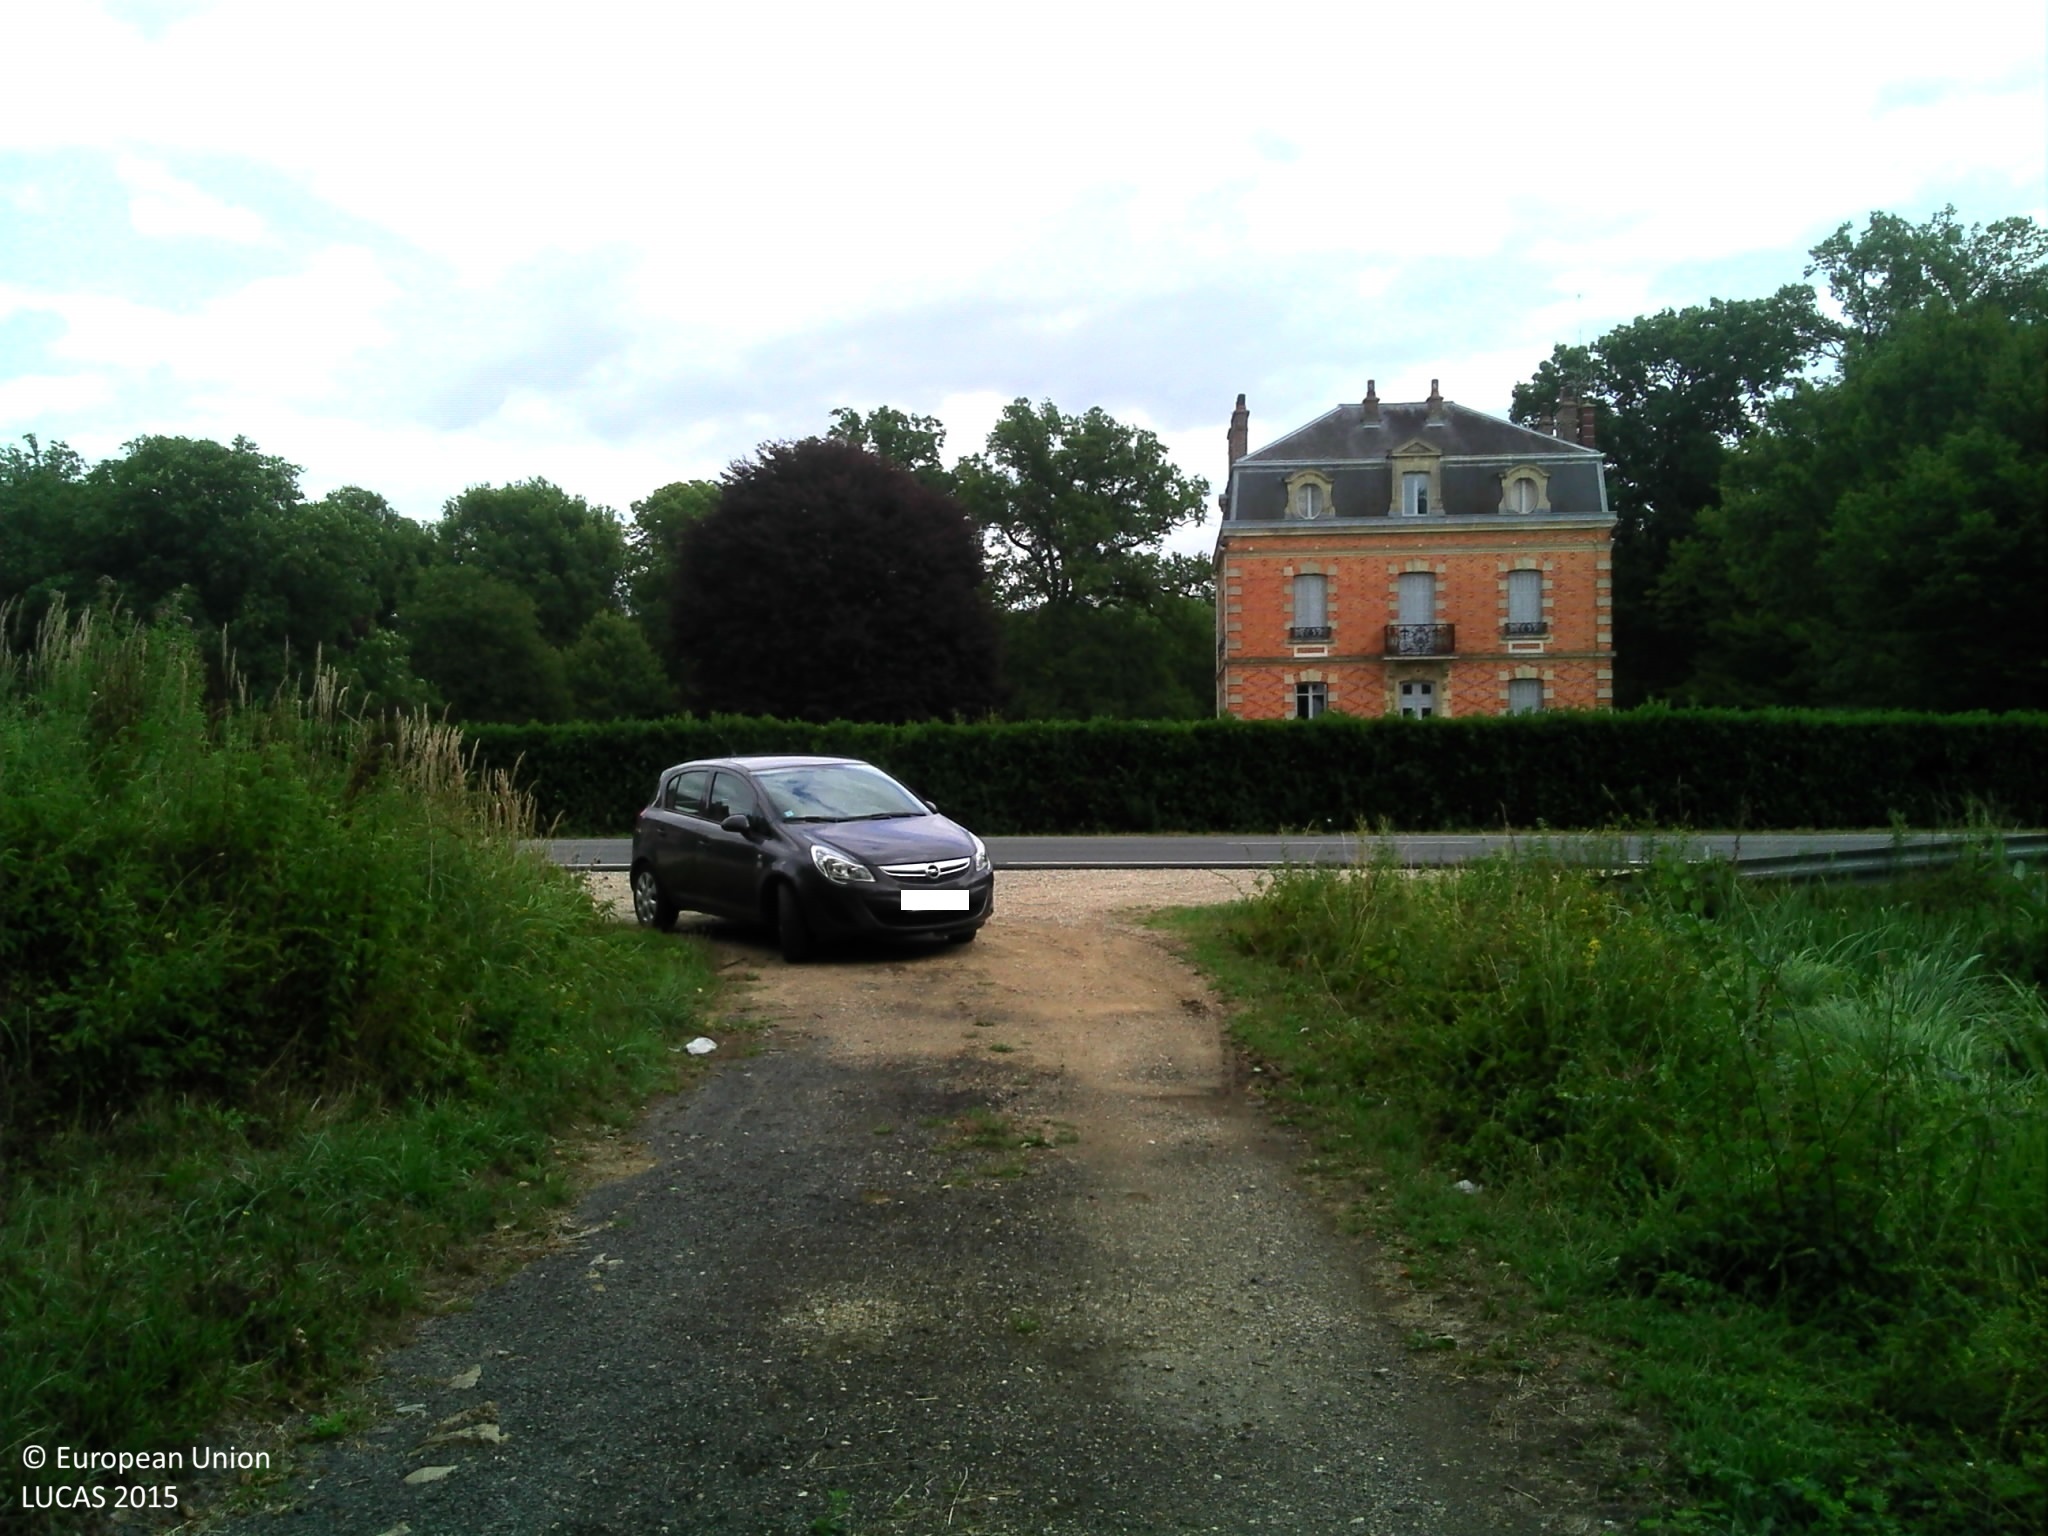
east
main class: Woodland
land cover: Broadleaved woodland
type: acidophilous oak and oak-birch forest
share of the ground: > 75 %
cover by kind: broadleaved forest trees 100 %
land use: Forestry
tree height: > 5 m
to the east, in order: Broadleaved woodland; Arable land (only in case pi); Broadleaved woodland
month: July
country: FR
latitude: 48.7214
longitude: 2.6905
